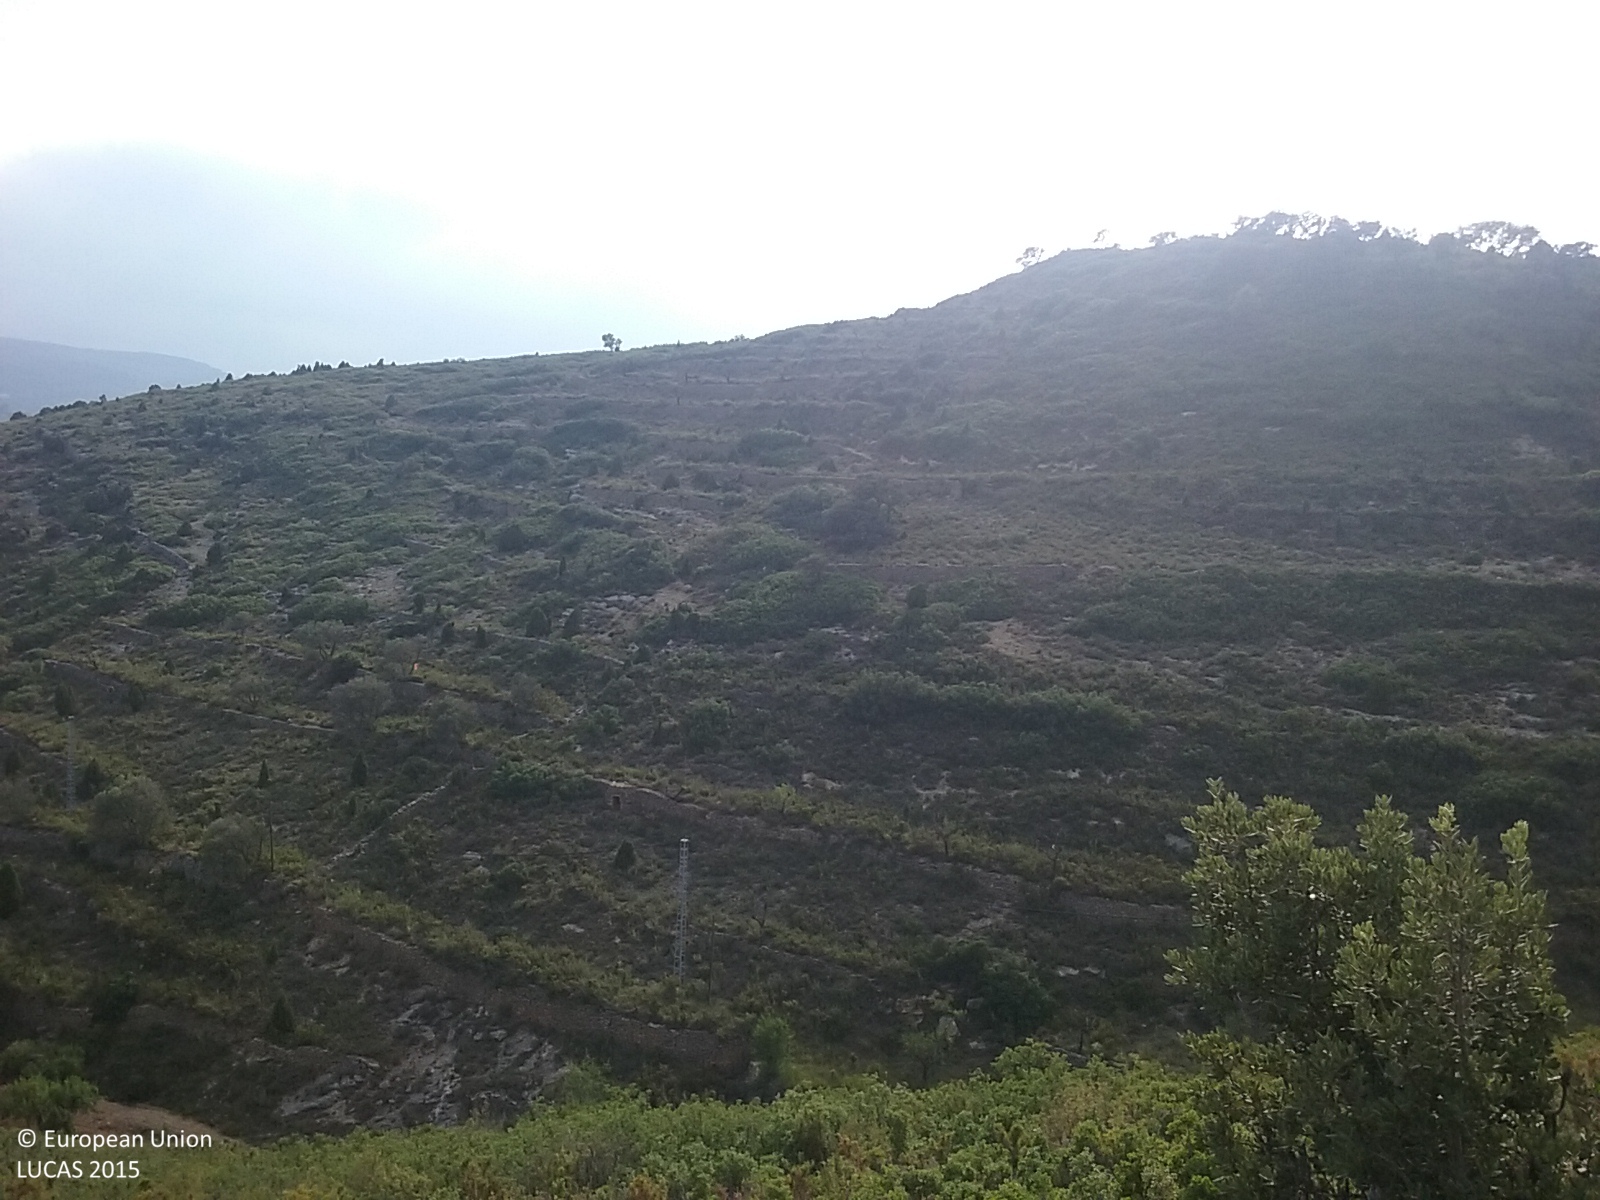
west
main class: Shrubland
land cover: Shrubland with sparse tree cover
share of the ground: > 75 %
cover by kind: shrubs 95 %, coniferous forest trees 5 %
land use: Semi-natural and natural areas not in use
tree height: < 5 m
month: August
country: ES
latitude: 40.3466
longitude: -0.0942
